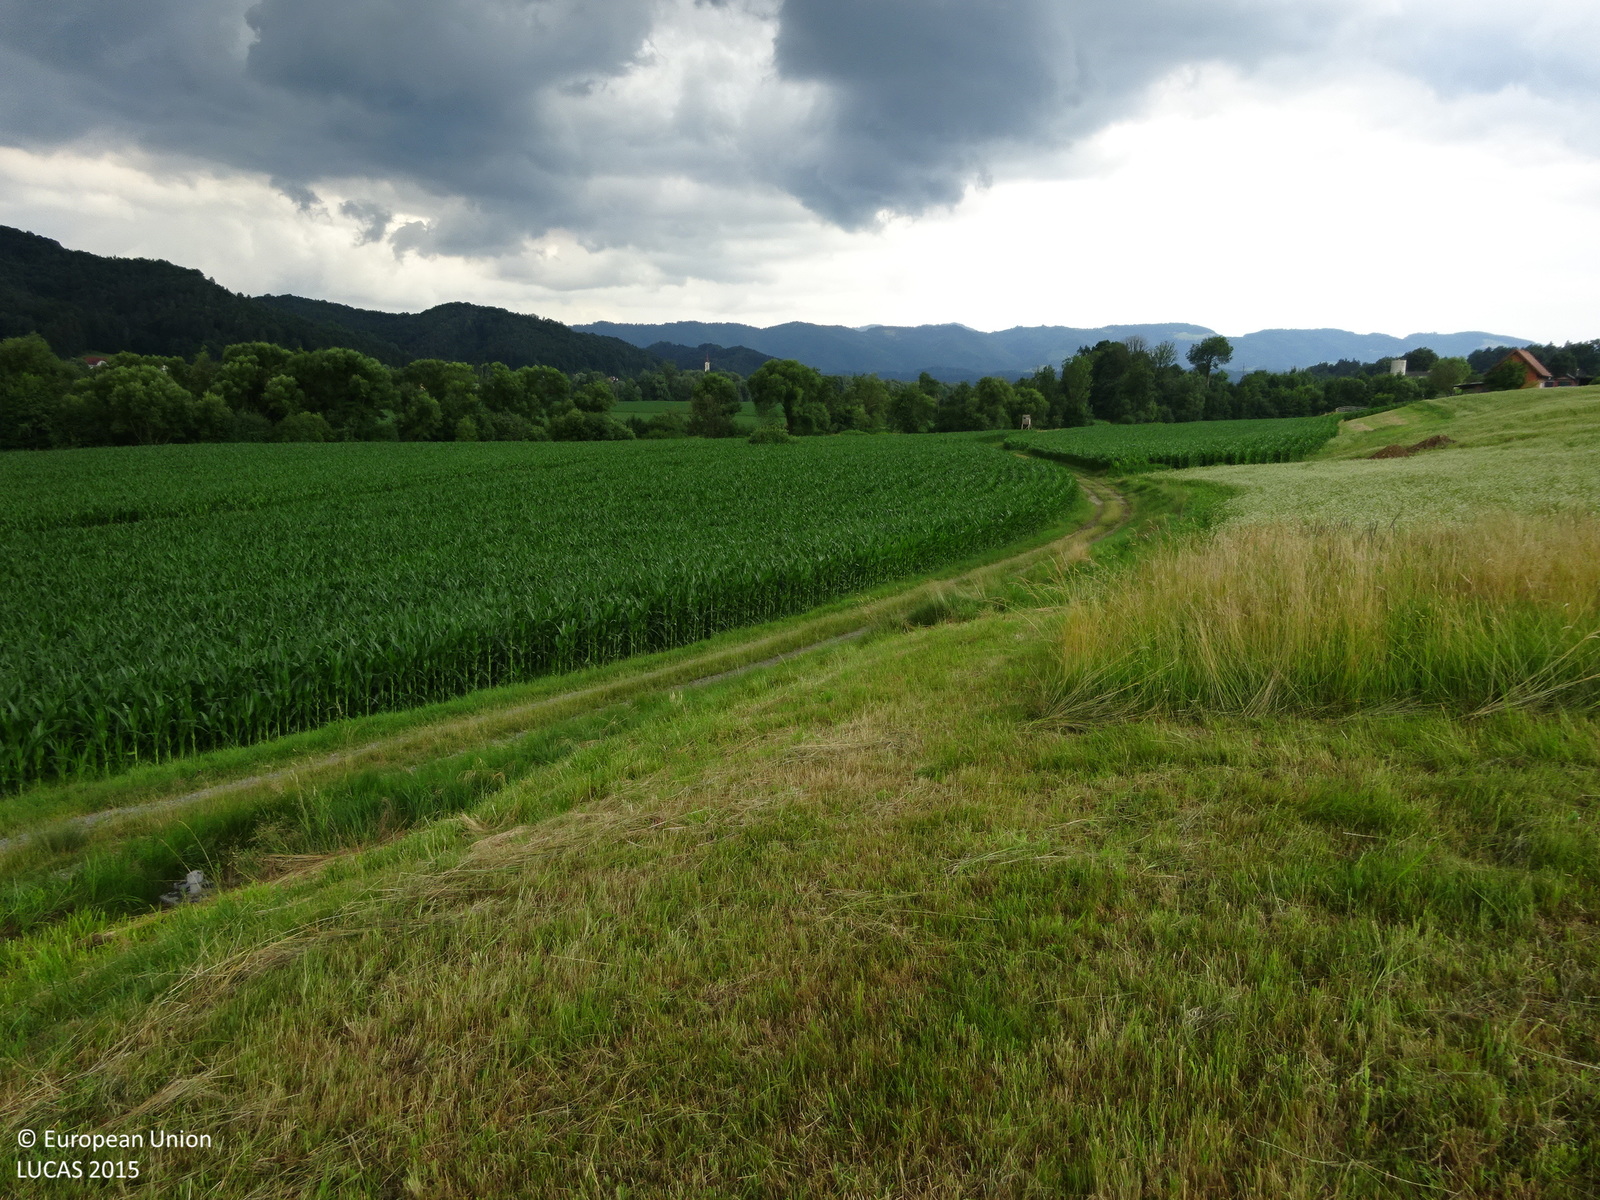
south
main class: Grassland
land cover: Grassland without tree/shrub cover
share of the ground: > 75 %
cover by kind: herbaceous plants 100 %
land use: Agriculture (excluding fallow land and kitchen gardens)
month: June
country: AT
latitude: 46.7201
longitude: 15.4023
